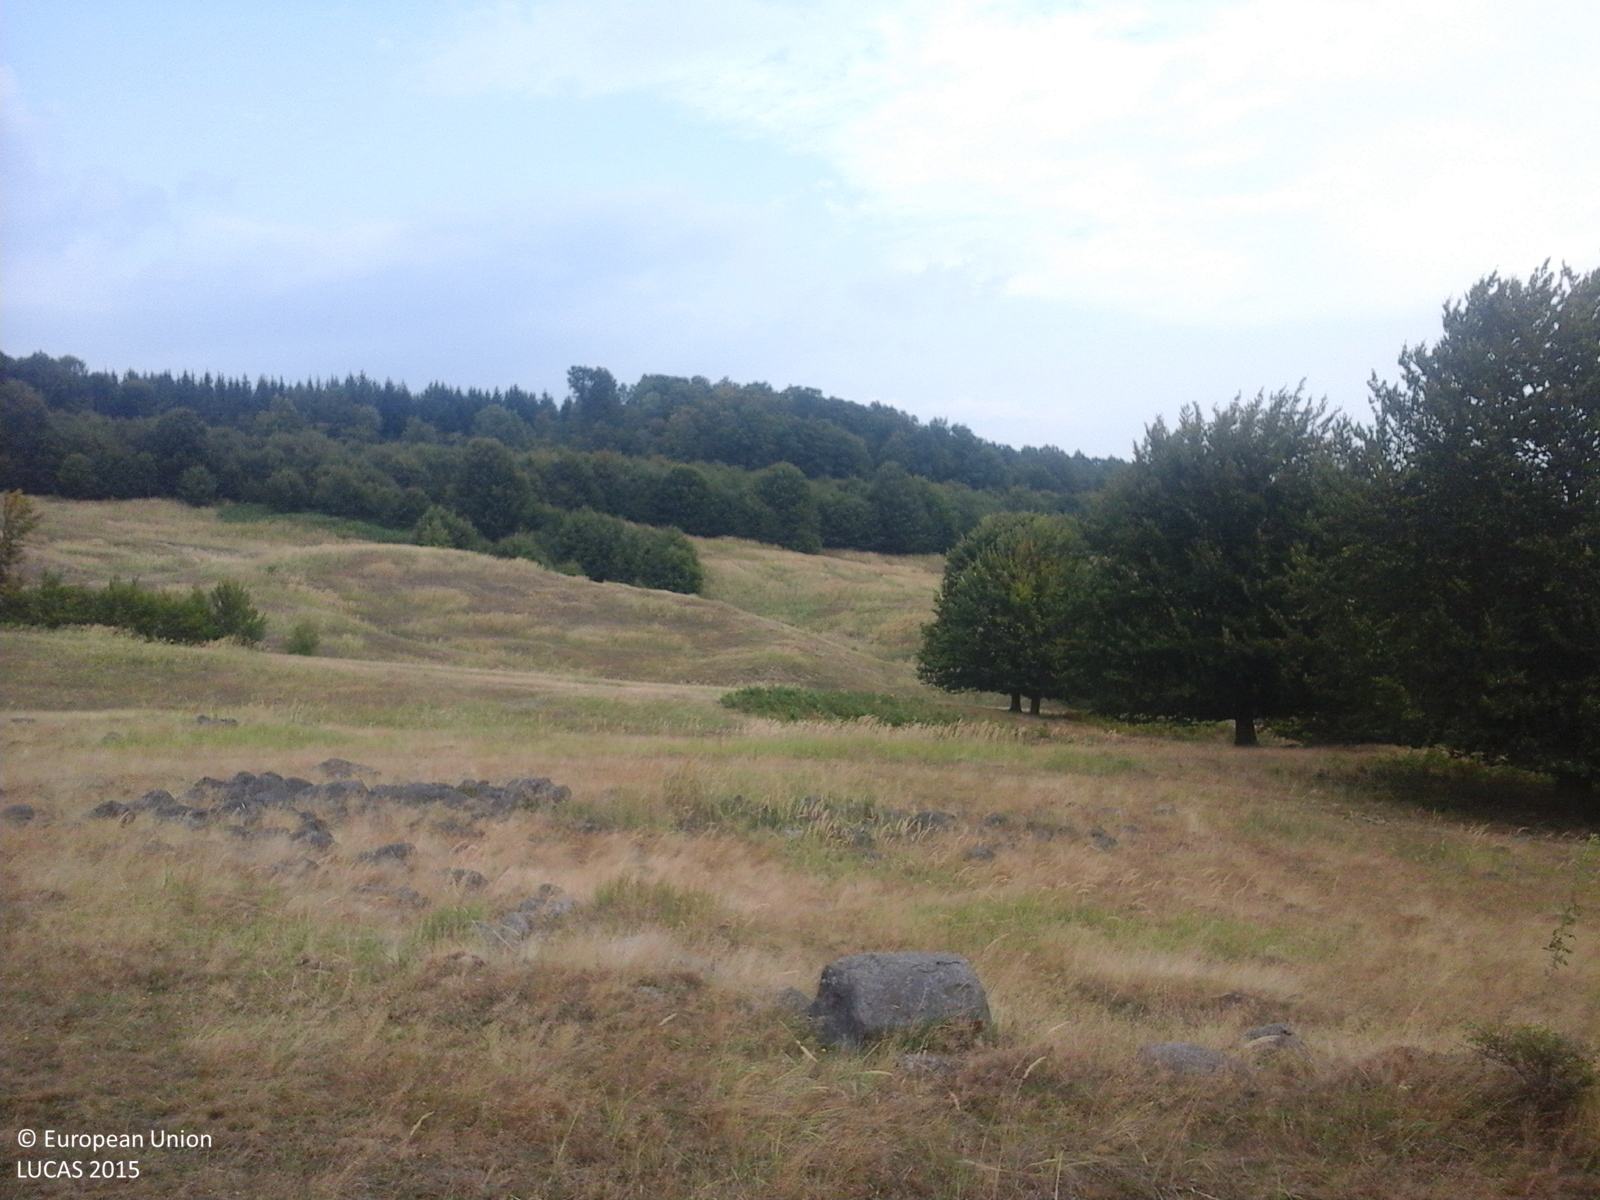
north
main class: Grassland
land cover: Grassland without tree/shrub cover
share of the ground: > 75 %
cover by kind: herbaceous plants 100 %
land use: Agriculture (excluding fallow land and kitchen gardens)
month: September
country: RO
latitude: 47.9785
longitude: 23.5959
